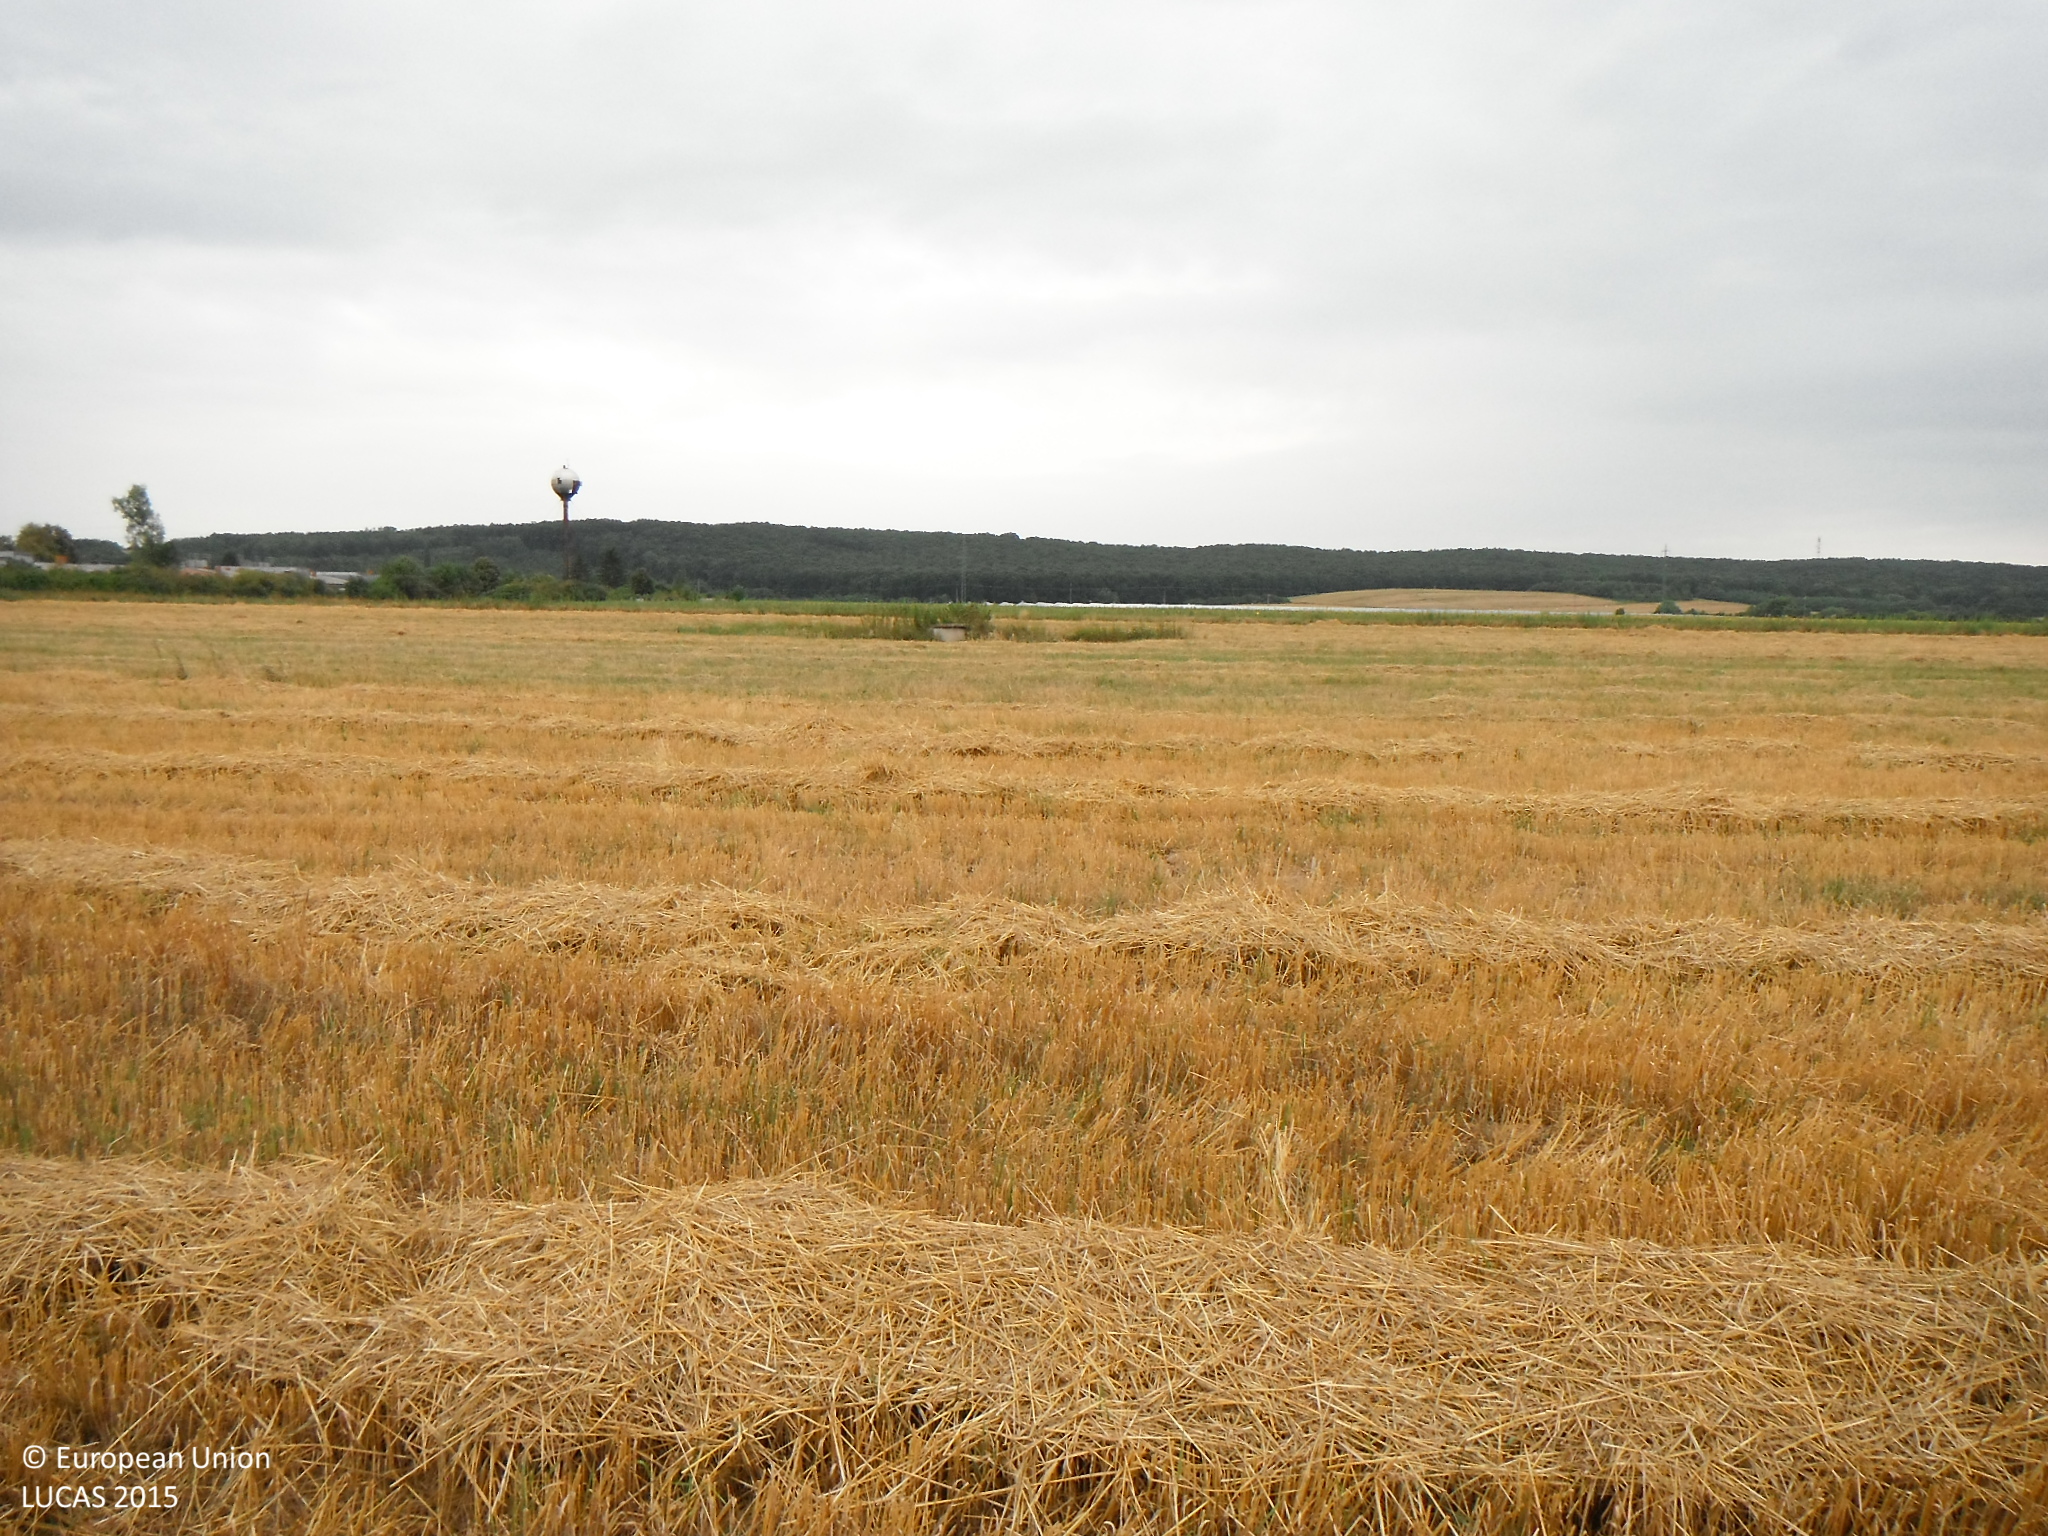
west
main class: Cropland
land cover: Barley
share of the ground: > 75 %
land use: Agriculture (excluding fallow land and kitchen gardens)
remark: Harvested field
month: July
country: SK
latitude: 48.3053
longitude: 19.6655
